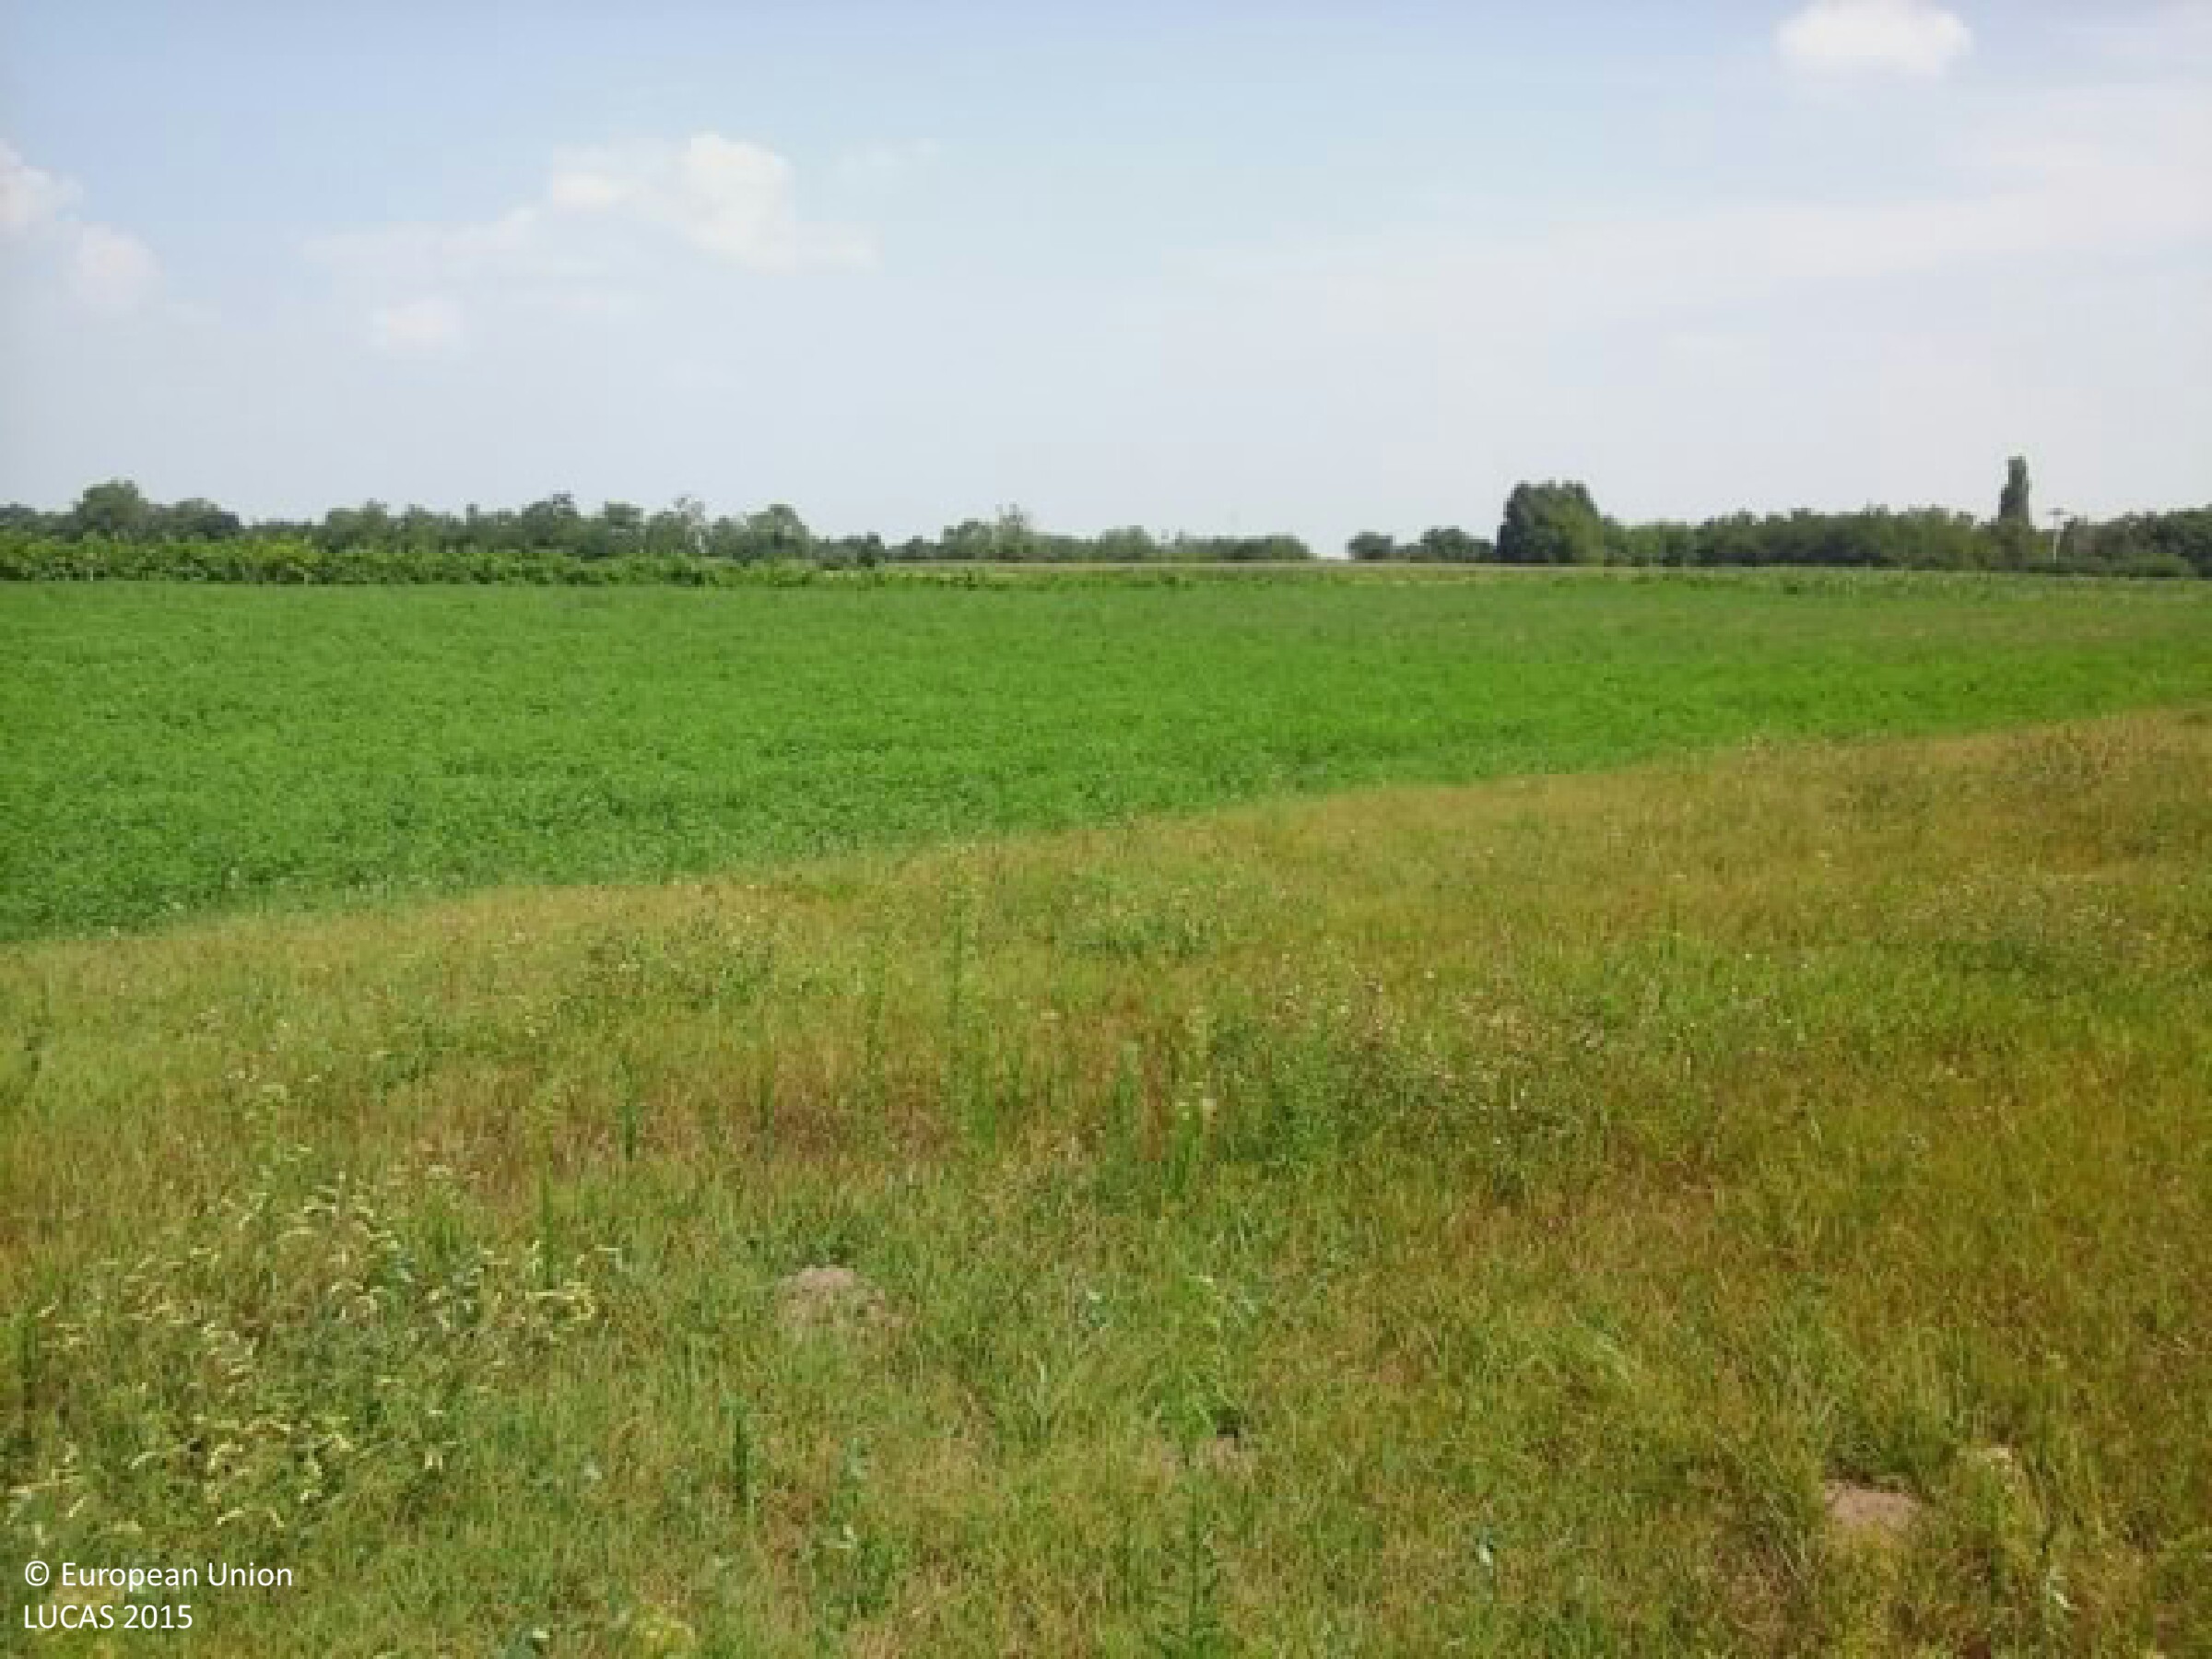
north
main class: Grassland
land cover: Grassland without tree/shrub cover
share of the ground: > 75 %
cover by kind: herbaceous plants 100 %
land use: Agriculture (excluding fallow land and kitchen gardens)
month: August
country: HU
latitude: 47.0753
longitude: 19.0108
